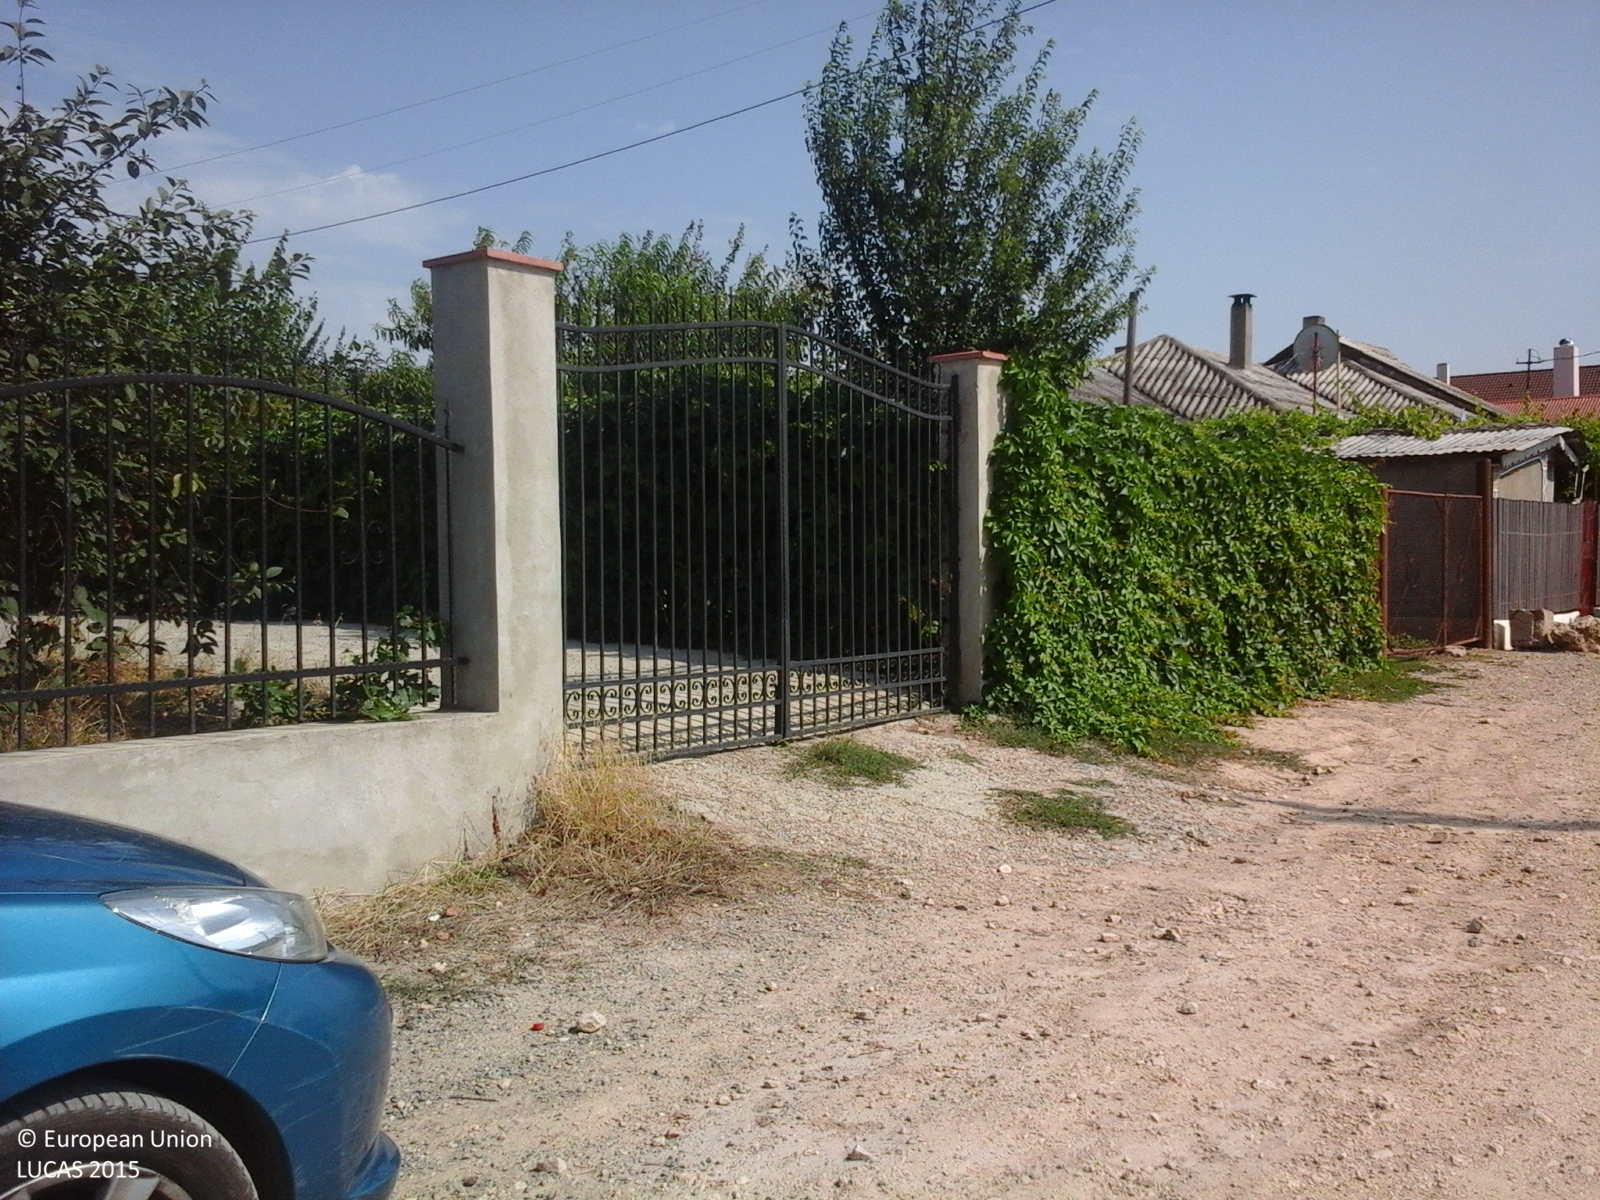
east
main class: Cropland
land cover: Other fruit trees and berries
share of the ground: 50 - 75 %
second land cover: Grassland without tree/shrub cover
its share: > 75 %
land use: Agriculture (excluding fallow land and kitchen gardens)
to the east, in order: Other fruit trees and berries; Grassland without tree/shrub cover; Lines of trees; Fences; Arable land (only in case pi); Artificial constructions in urban areas; Arable land (only in case pi); Maize; Fences; Grassland without tree/shrub cover; Artificial constructions in urban areas; Grass margins; Common wheat; Electric lines; Common wheat
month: August
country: RO
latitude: 44.2018
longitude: 28.3988
